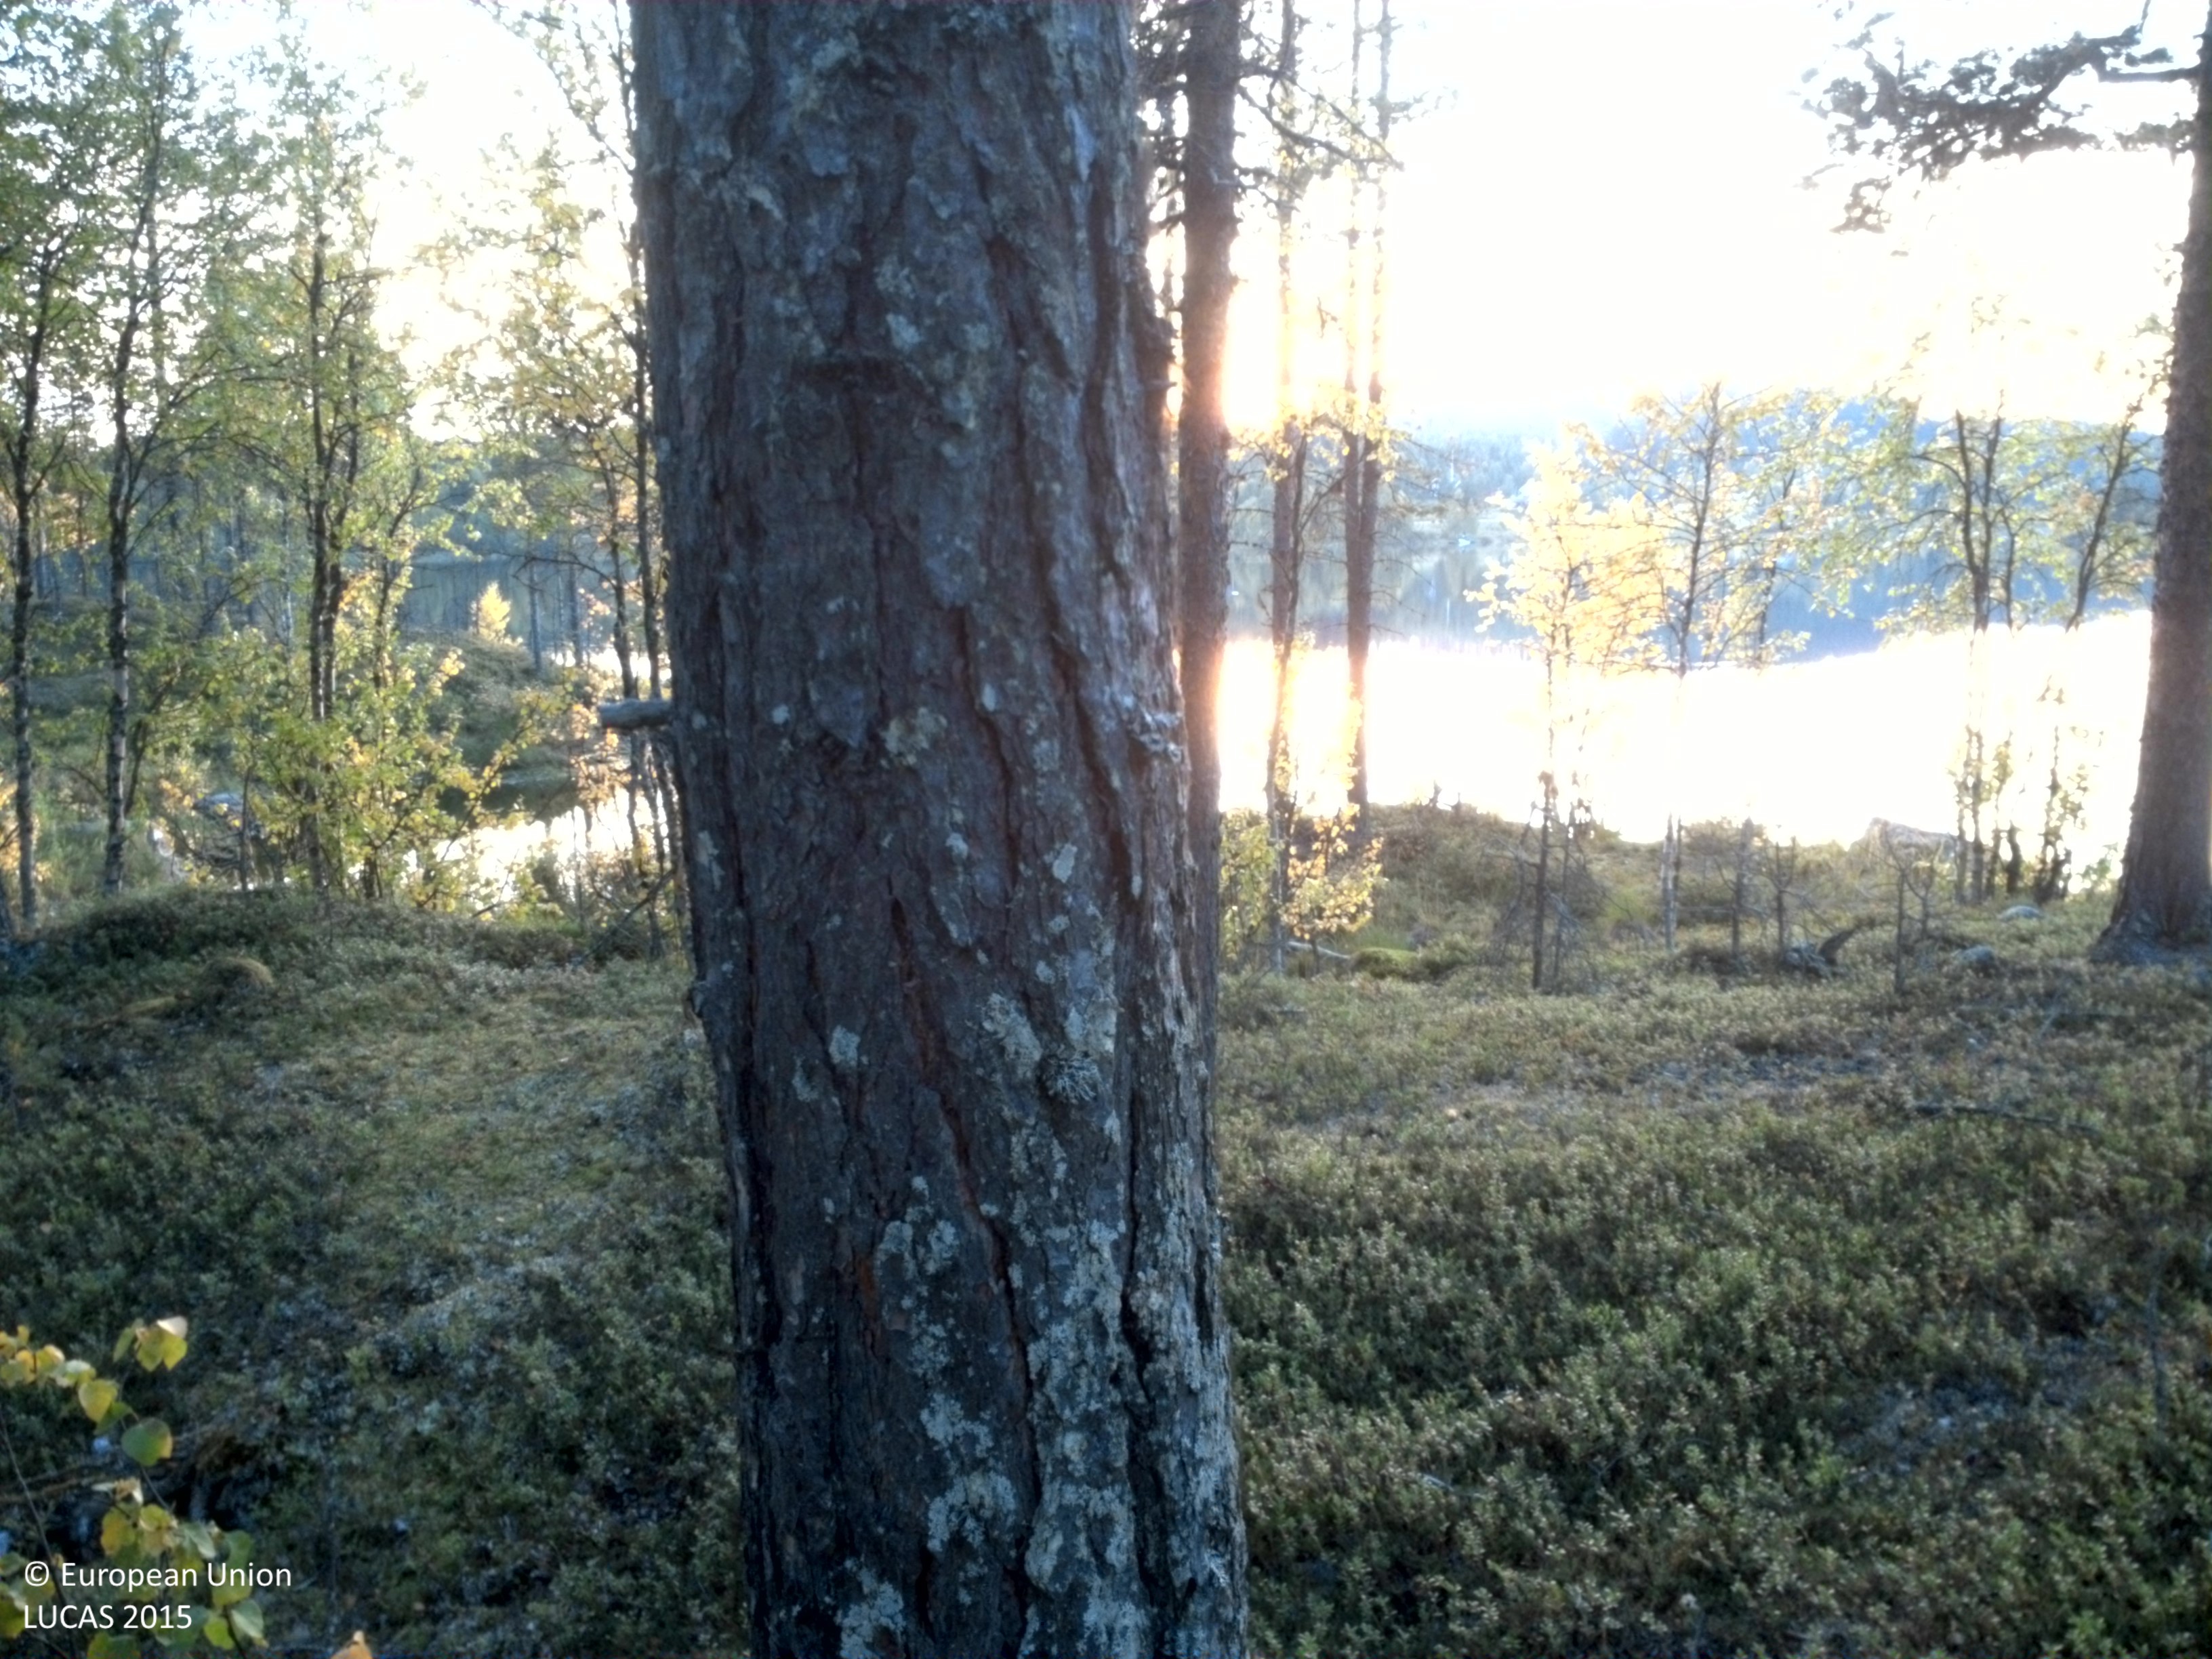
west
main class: Woodland
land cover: Pine dominated mixed woodland
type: boreal forest
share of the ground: 25 - 50 %
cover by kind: shrubs 45 %, broadleaved forest trees 30 %, lichens and mosses 15 %, coniferous forest trees 10 %
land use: Forestry
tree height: > 5 m
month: September
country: SE
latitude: 65.3293
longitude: 16.6398
